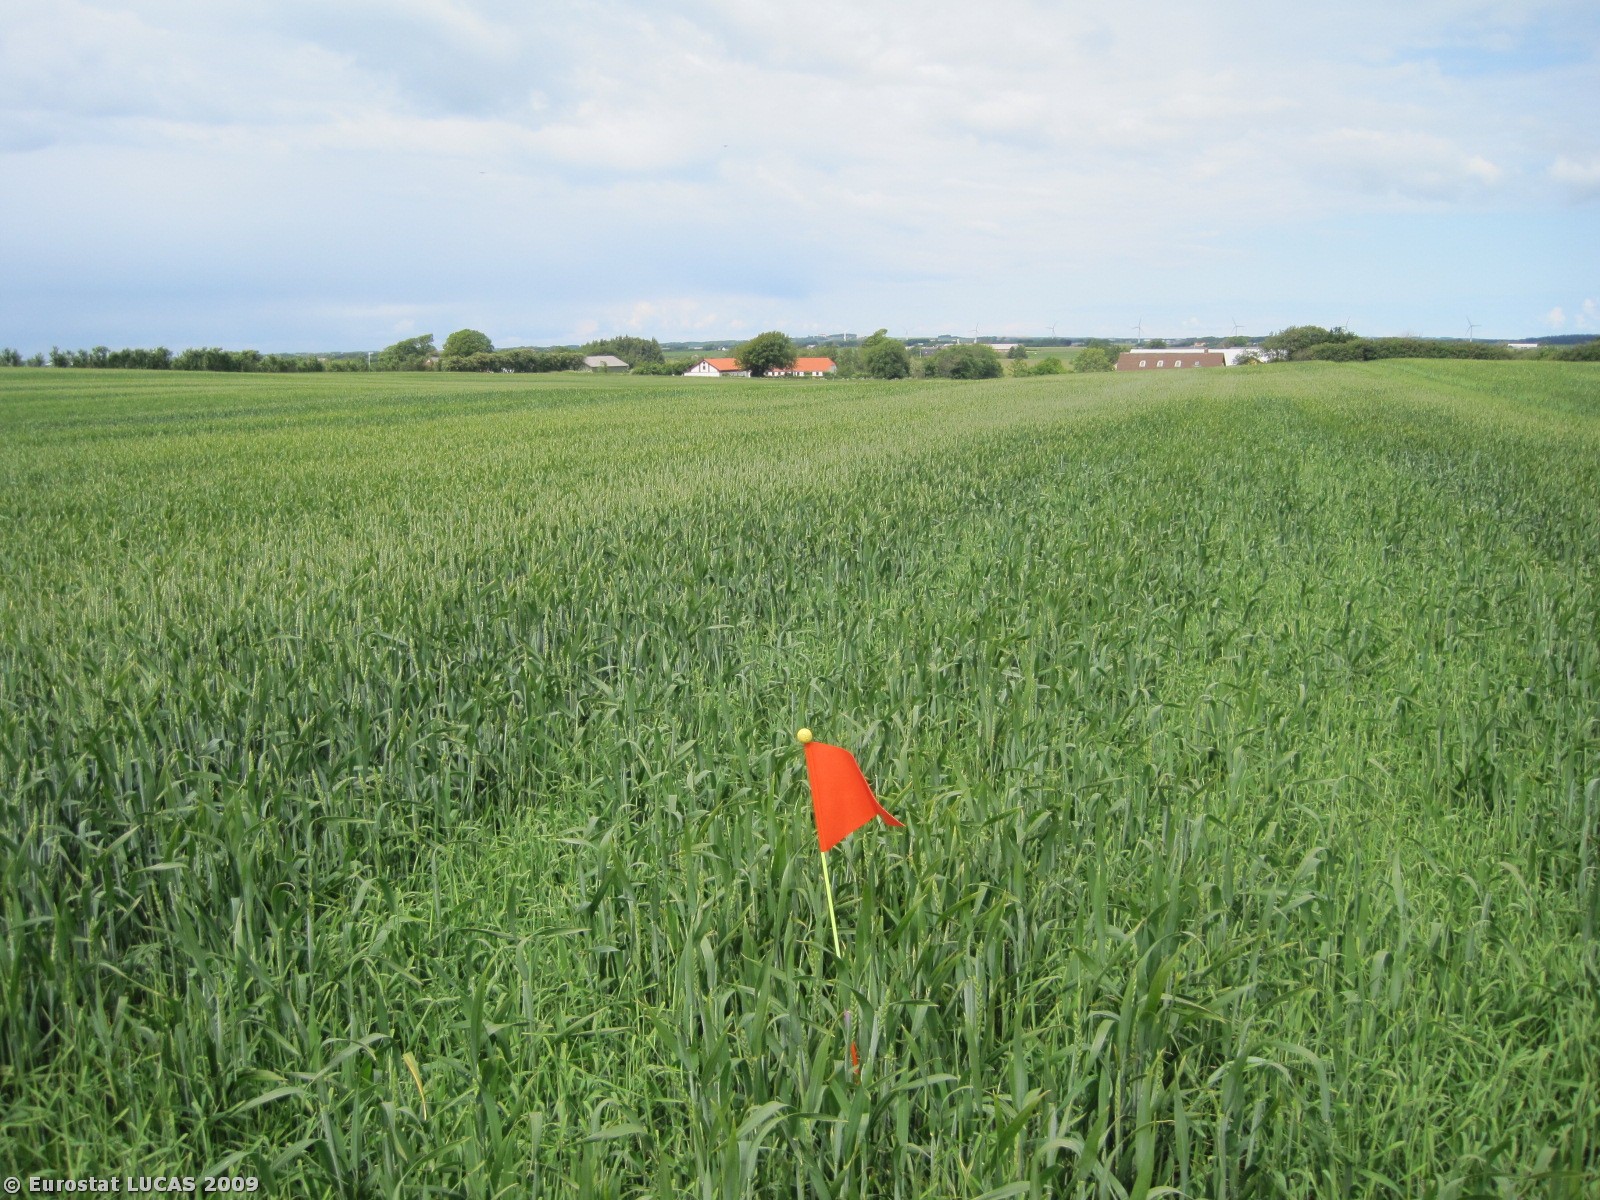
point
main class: Cropland
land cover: Common wheat
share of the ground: 50 - 75 %
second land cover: Barley
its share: 10 - 25 %
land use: Agriculture (excluding fallow land and kitchen gardens)
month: June
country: DK
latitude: 57.3023
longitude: 9.8509
